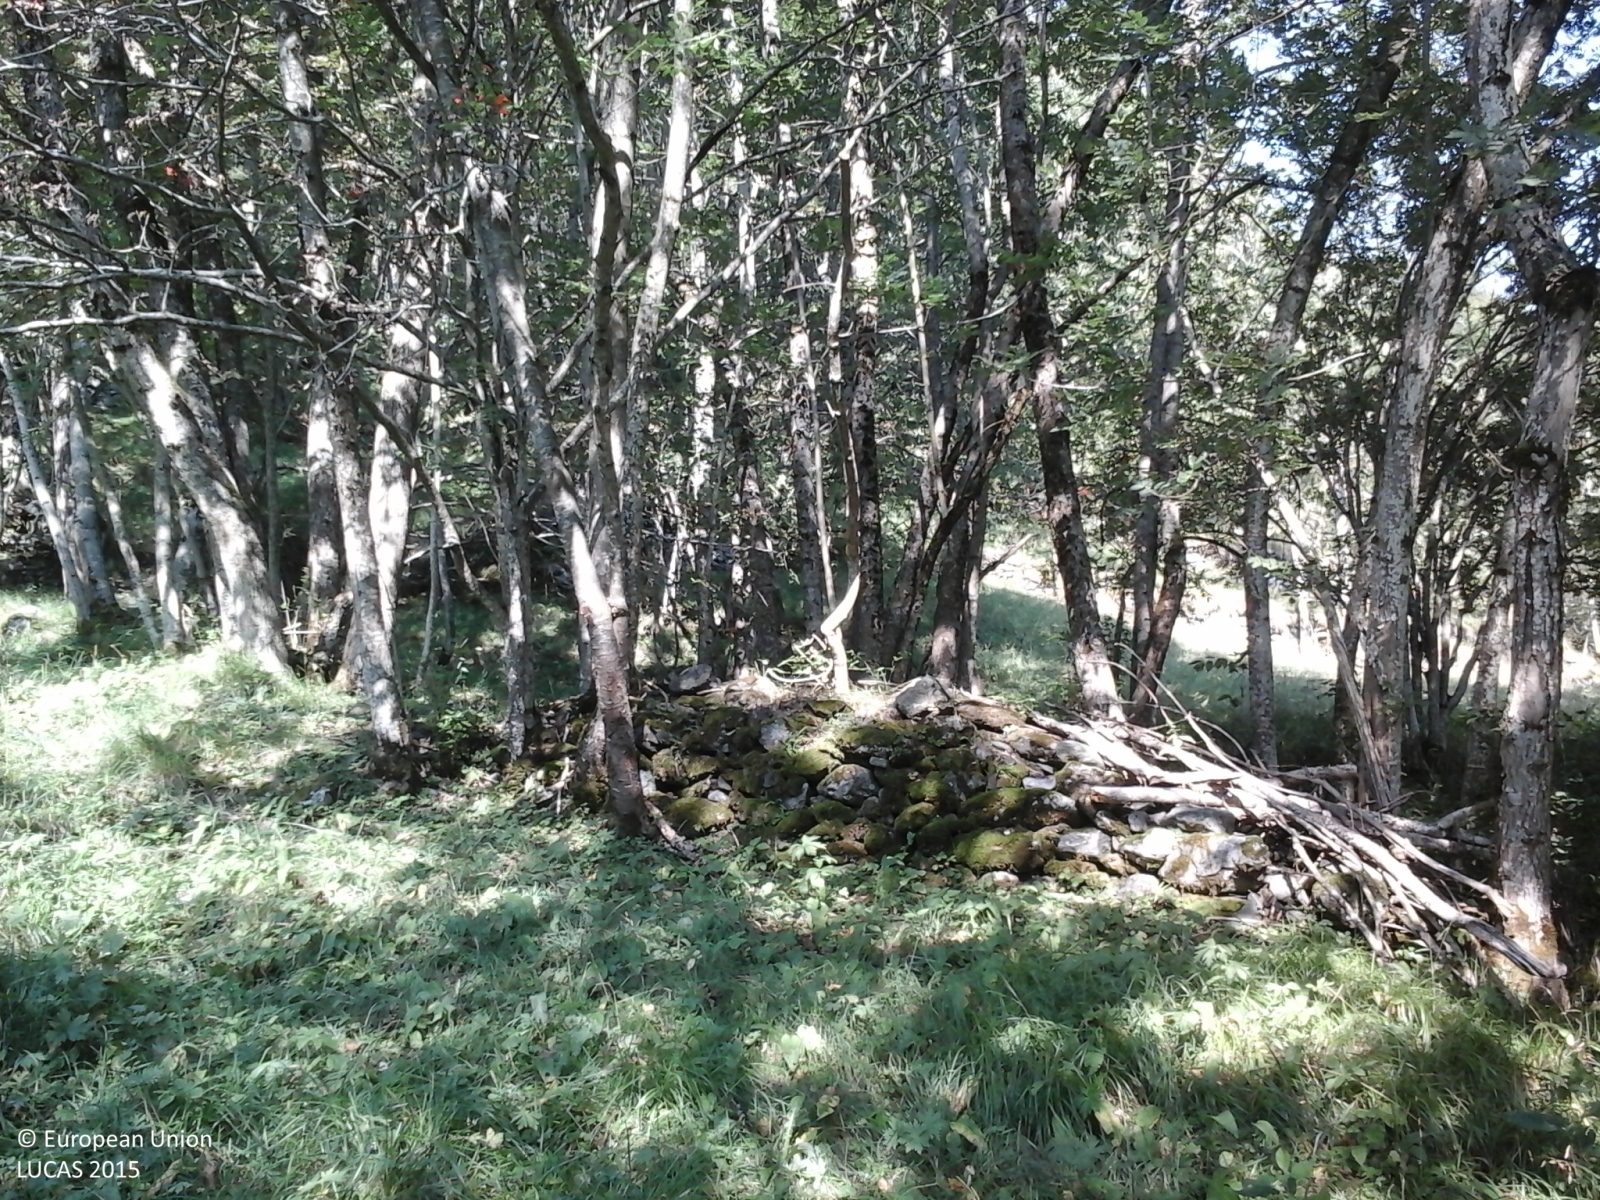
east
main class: Woodland
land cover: Broadleaved woodland
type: thermophilous deciduous forest
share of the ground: > 75 %
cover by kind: broadleaved forest trees 70 %, herbaceous plants 20 %, shrubs 10 %
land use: Forestry
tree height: > 5 m
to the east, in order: Broadleaved woodland; Ditches and canals; Broadleaved woodland; Dry stone walls; Broadleaved woodland; Dry stone walls; Spontaneously vegetated surfaces; Electric lines; Spontaneously vegetated surfaces; Broadleaved woodland; Grassland without tree/shrub cover; Paved roads, cycling and walking lanes
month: August
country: IT
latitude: 45.6221
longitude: 7.6308
